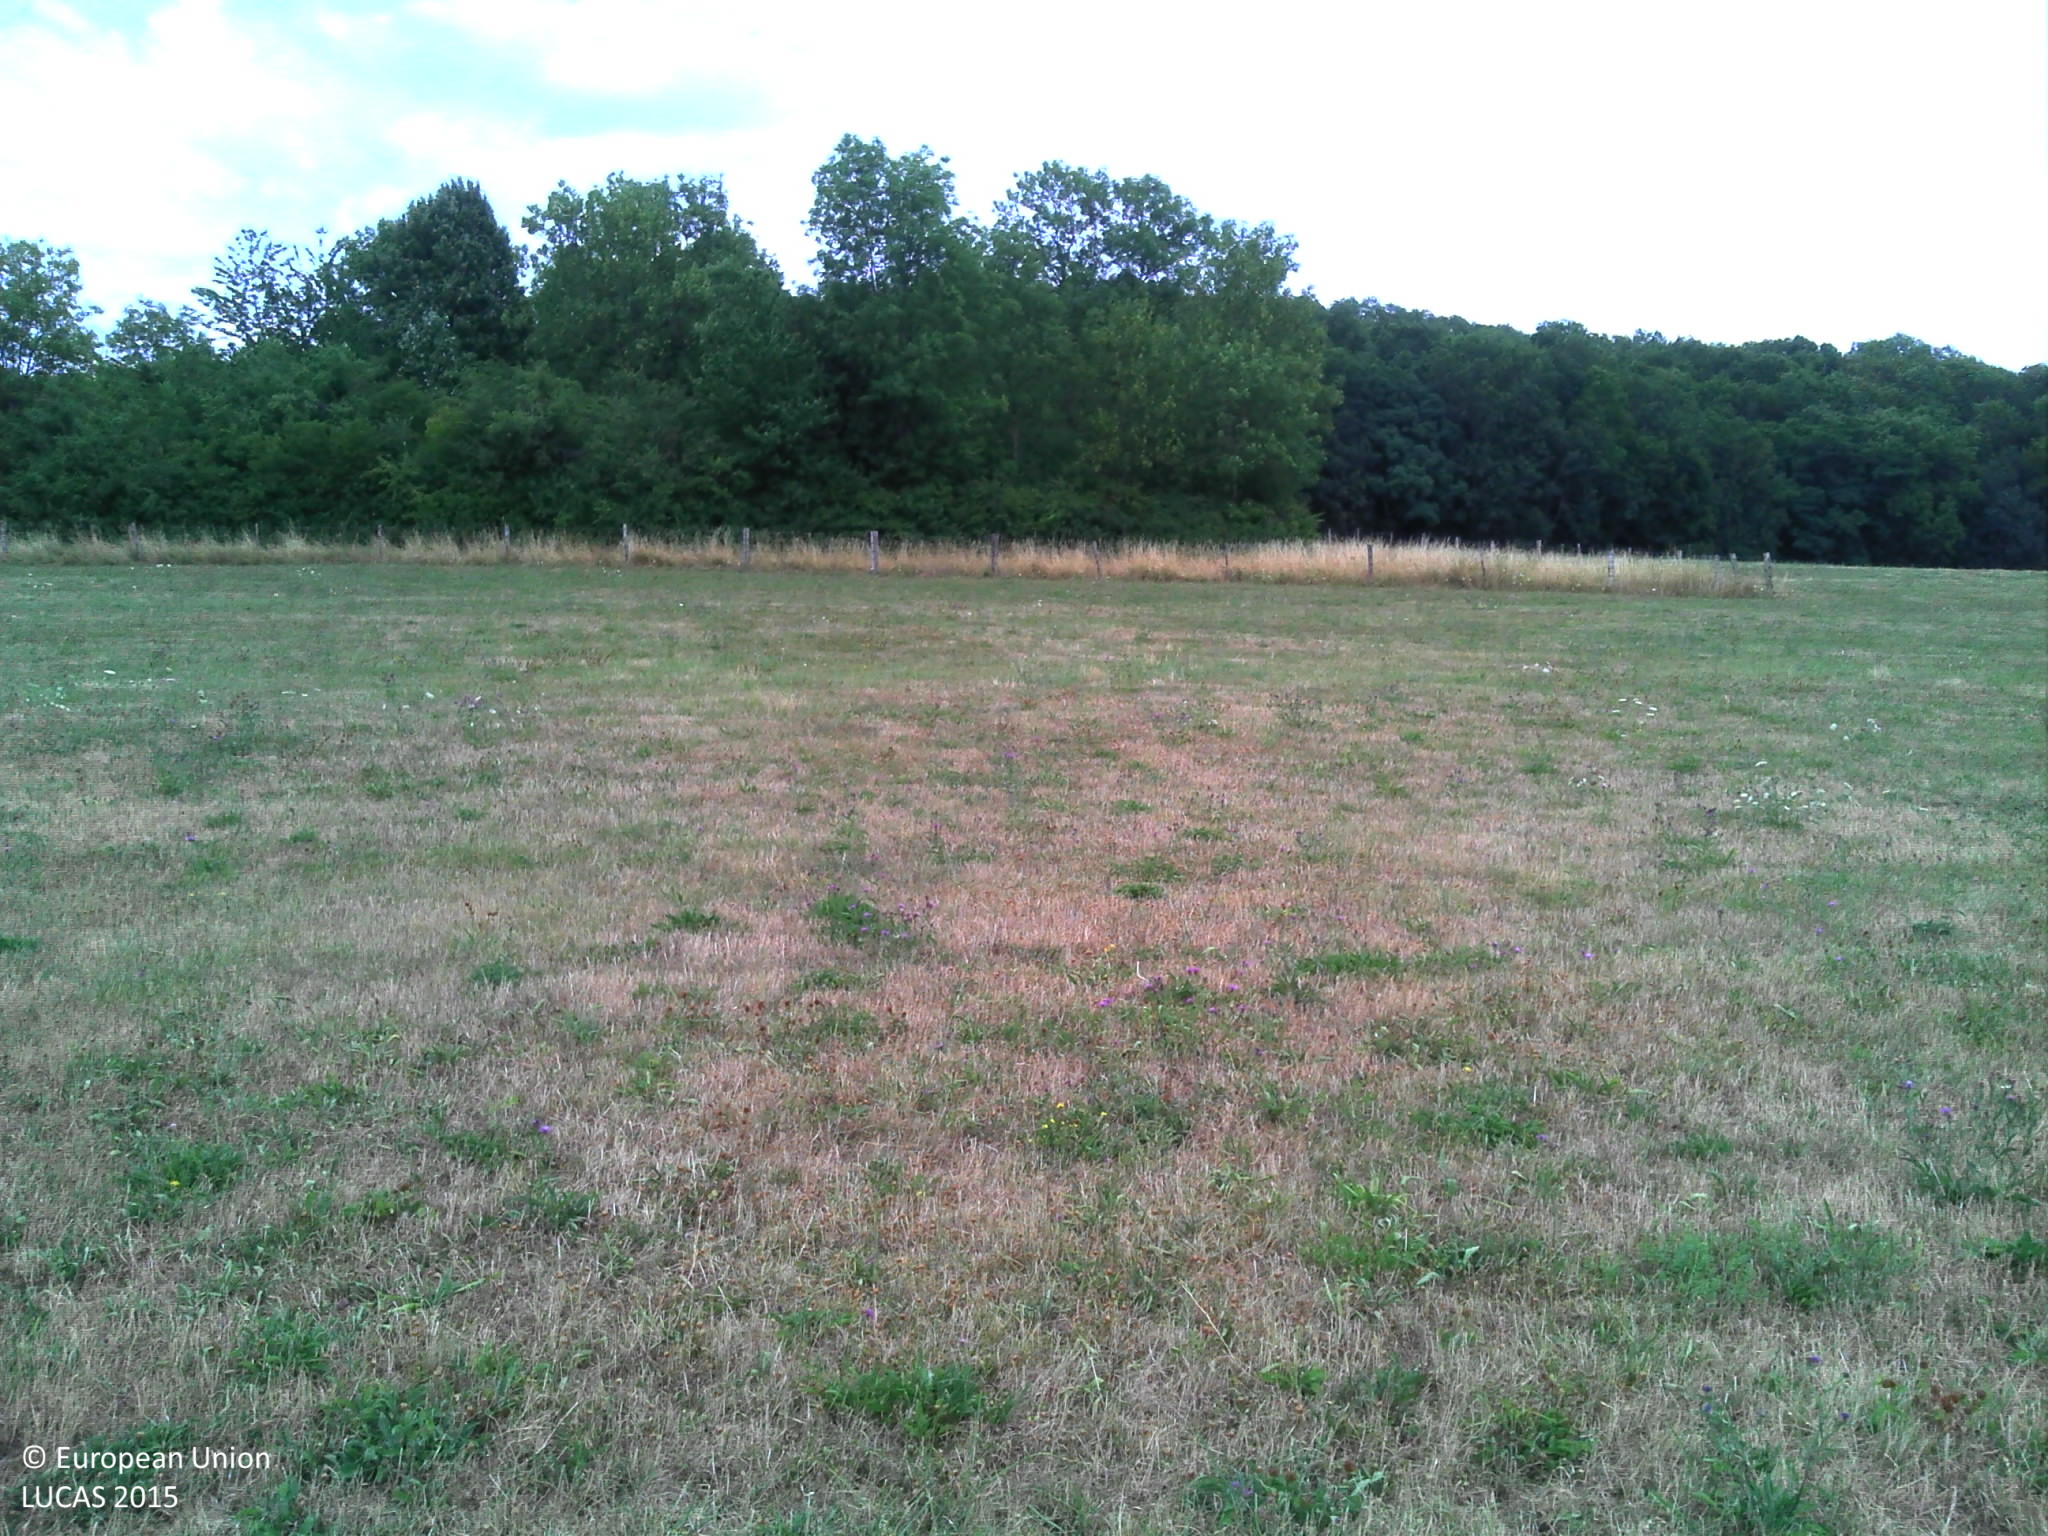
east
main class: Grassland
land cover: Grassland without tree/shrub cover
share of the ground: > 75 %
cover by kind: herbaceous plants 100 %
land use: Agriculture (excluding fallow land and kitchen gardens)
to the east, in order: Grassland without tree/shrub cover; Fences; Grassland without tree/shrub cover; Tracks; Broadleaved woodland; Fences; Grassland without tree/shrub cover; Fences; Abandoned hedges; Grassland without tree/shrub cover; Abandoned hedges; Grassland without tree/shrub cover; Tracks; Broadleaved woodland; Tracks; Broadleaved woodland
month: July
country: FR
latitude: 48.4237
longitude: 6.0677
